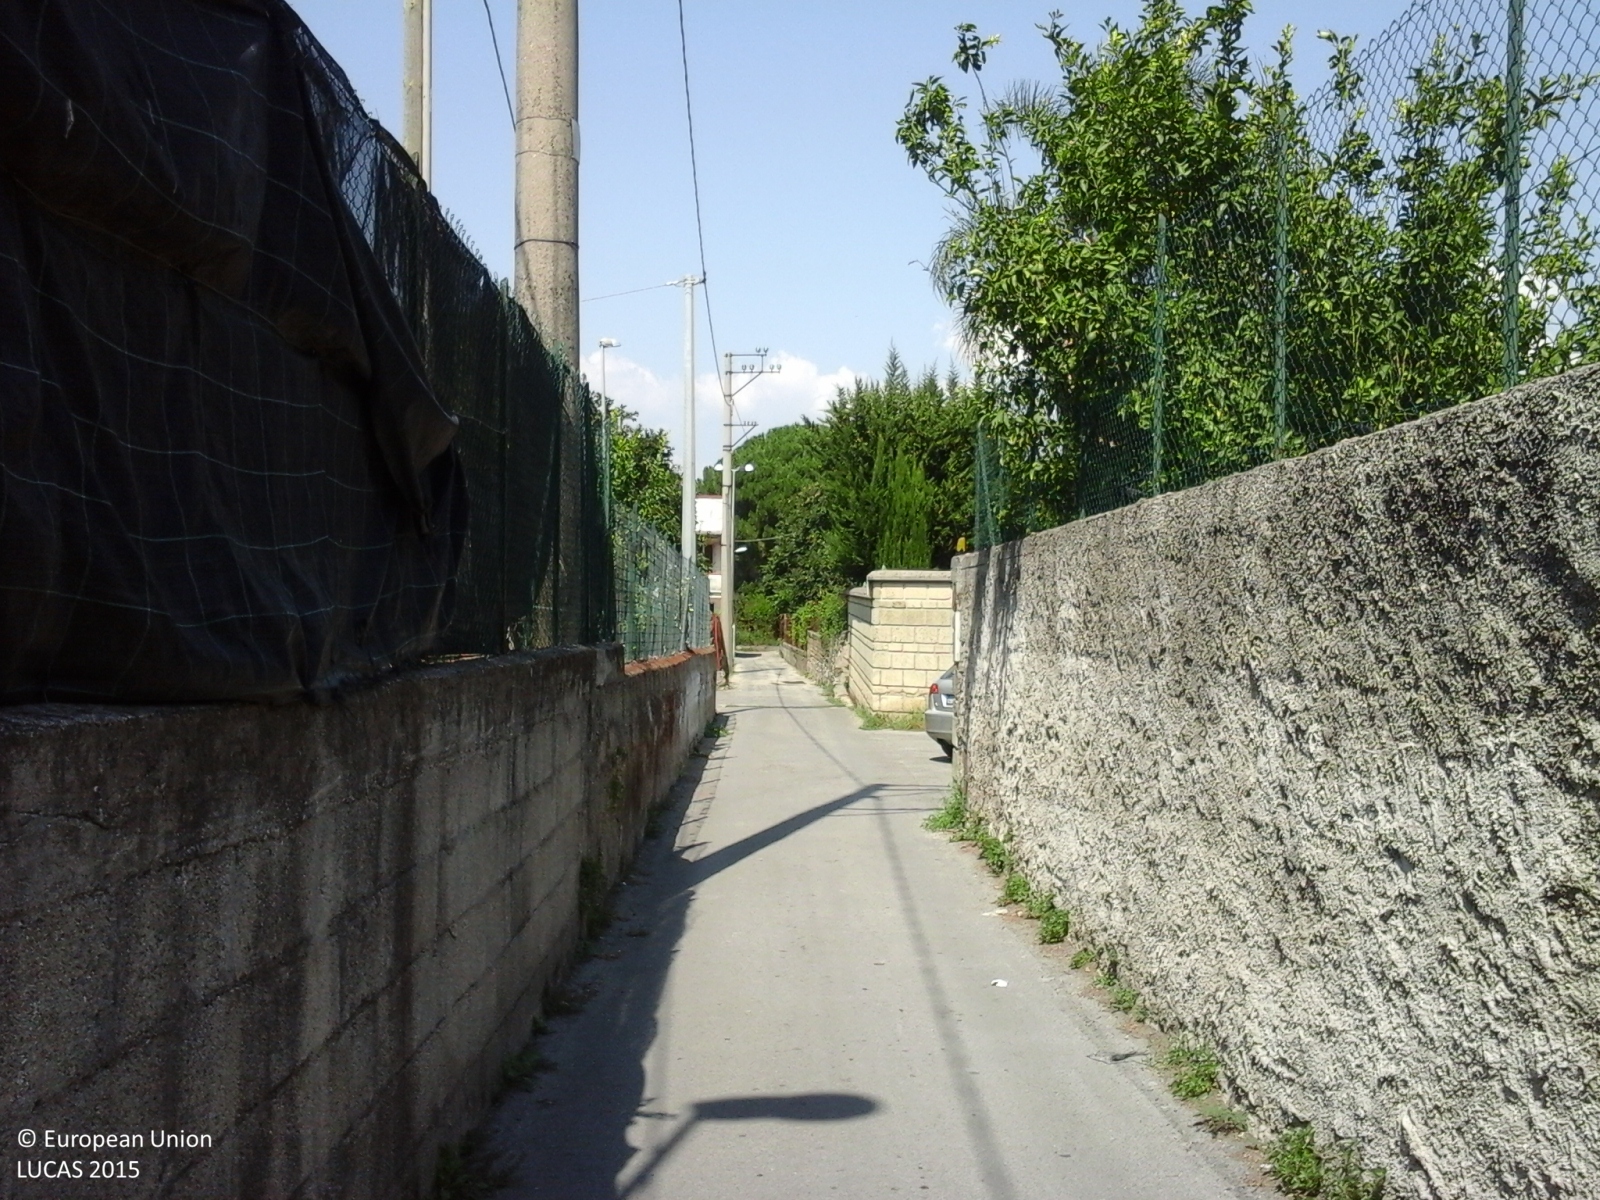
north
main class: Cropland
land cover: Permanent crops (only in case pi)
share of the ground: > 75 %
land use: Kitchen garden
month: September
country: IT
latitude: 40.7399
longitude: 14.5874
